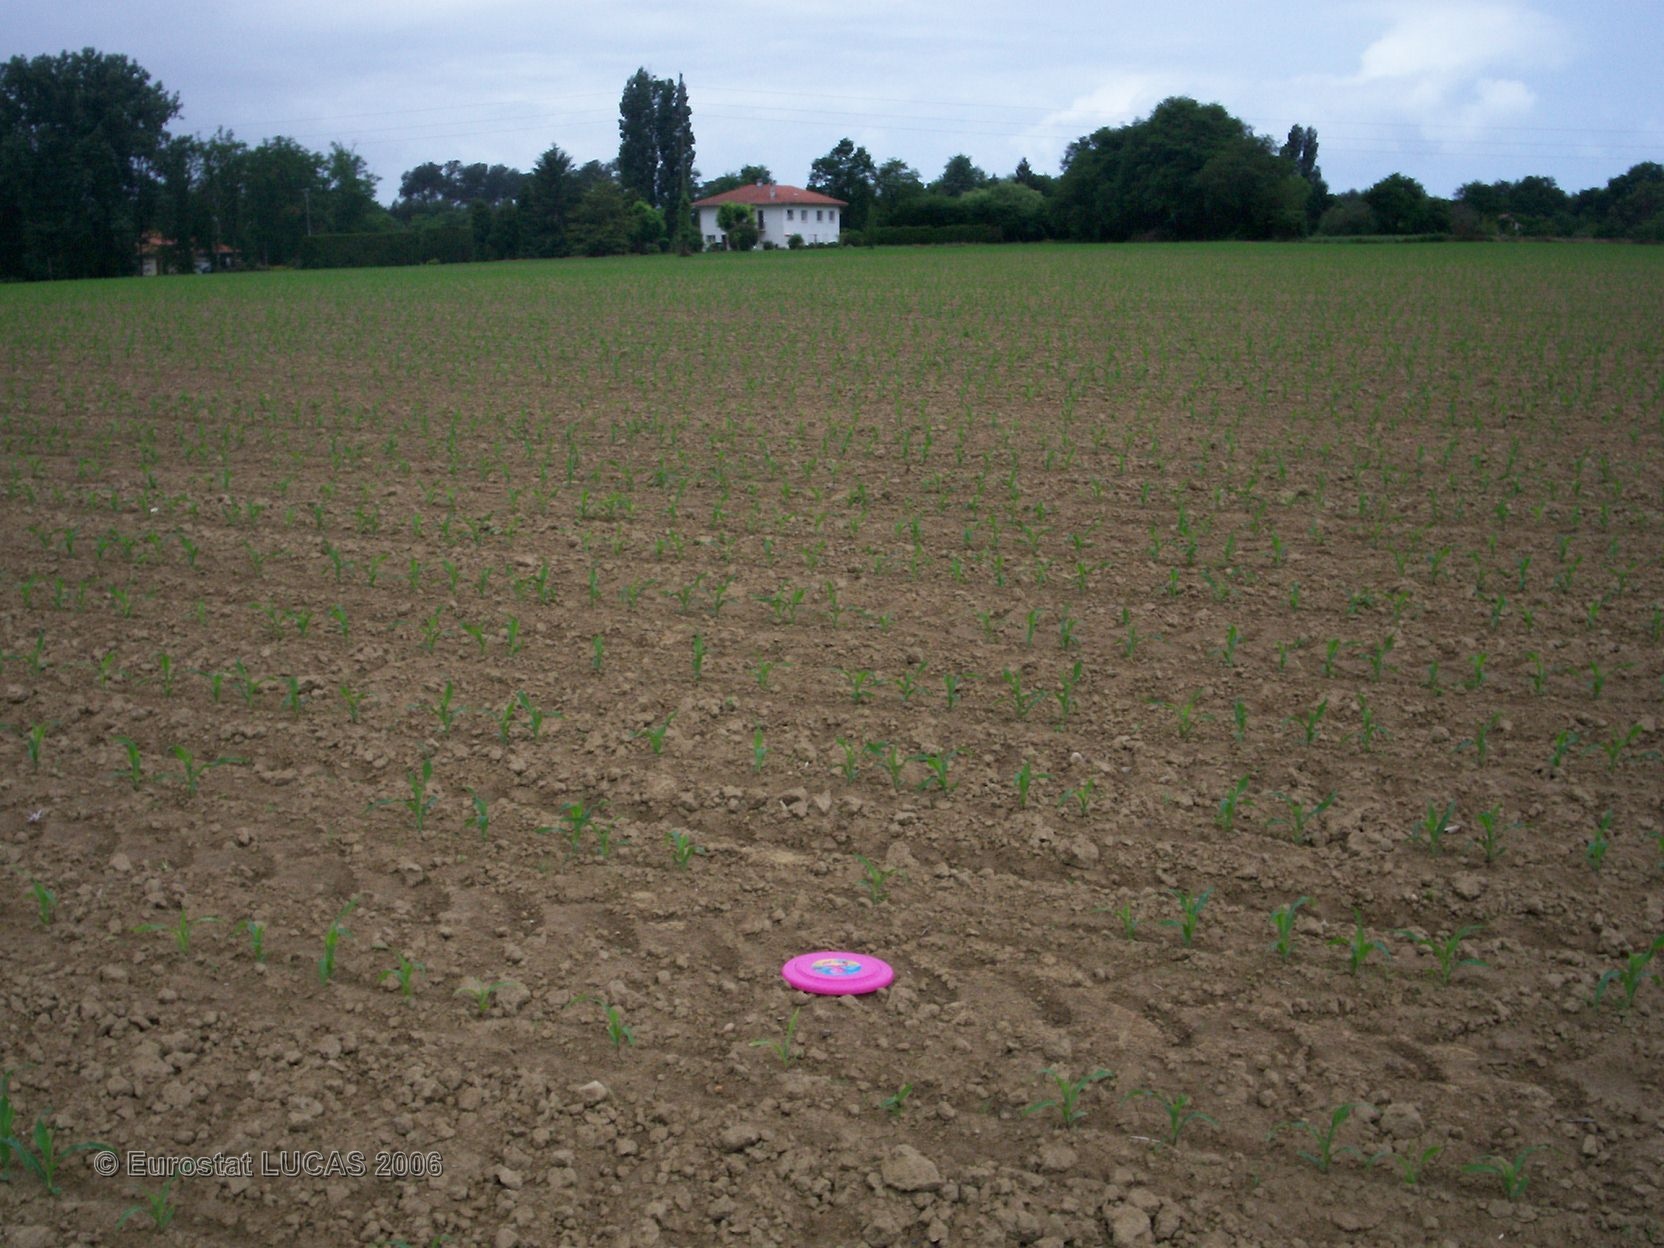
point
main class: Cropland
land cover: Maize
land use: Agriculture (excluding fallow land and kitchen gardens)
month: May
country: FR
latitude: 43.5570
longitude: -1.3944
